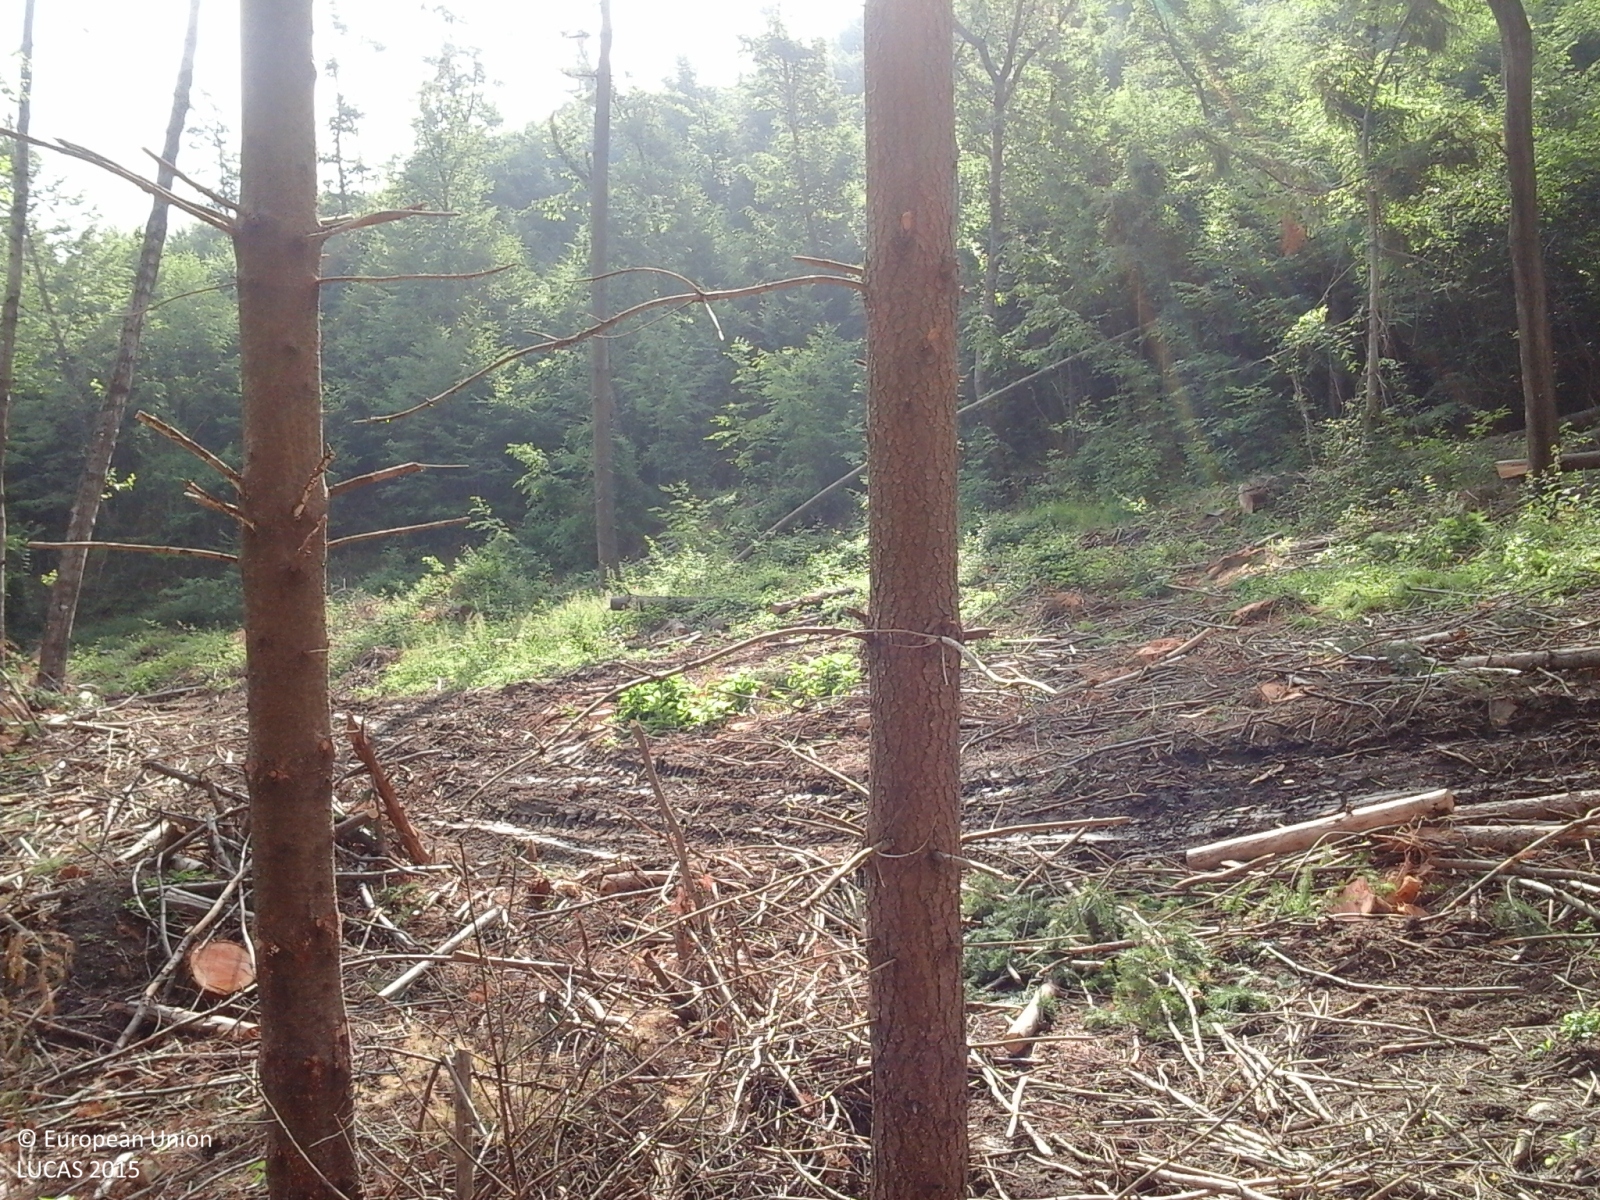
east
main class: Woodland
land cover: Other coniferous woodland
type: coniferous forest of the mediterranean region
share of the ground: > 75 %
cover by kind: coniferous forest trees 80 %, broadleaved forest trees 20 %
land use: Forestry
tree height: > 5 m
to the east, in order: Other coniferous woodland; Broadleaved woodland
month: June
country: IT
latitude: 43.8507
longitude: 11.6255
